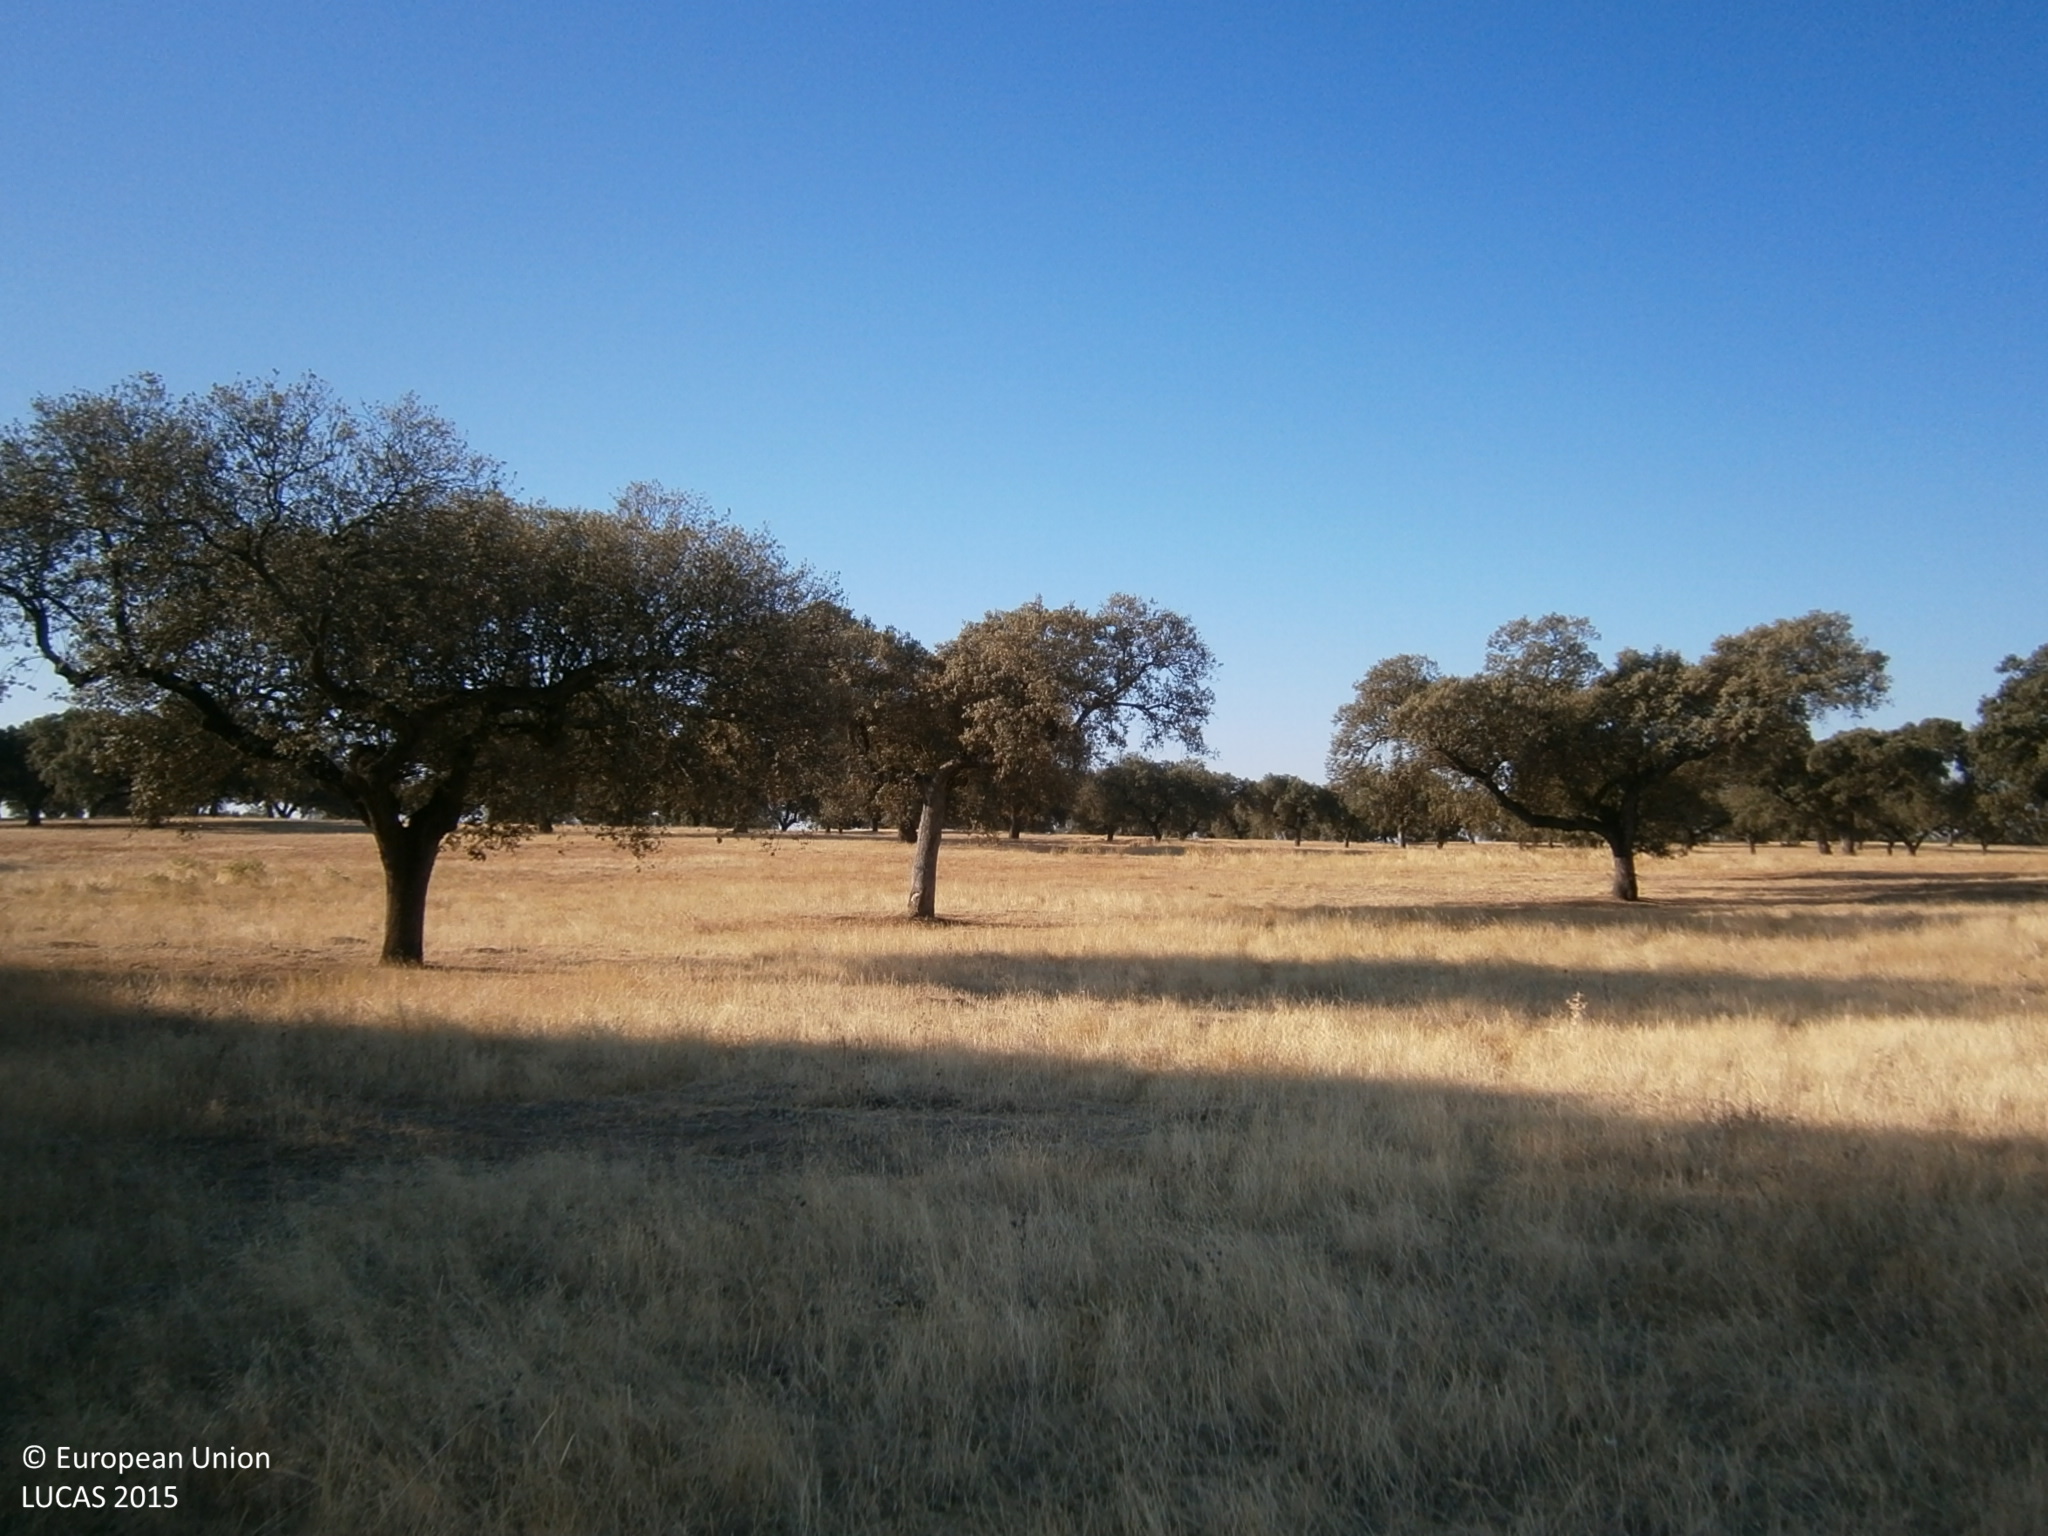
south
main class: Woodland
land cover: Broadleaved woodland
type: broadleaved evergreen forest
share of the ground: > 75 %
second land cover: Spontaneously vegetated surfaces
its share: > 75 %
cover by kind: broadleaved forest trees 90 %, shrubs 5 %
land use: Forestry
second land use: Agriculture (excluding fallow land and kitchen gardens)
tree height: > 5 m
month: July
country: ES
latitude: 38.9684
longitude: -6.7207
